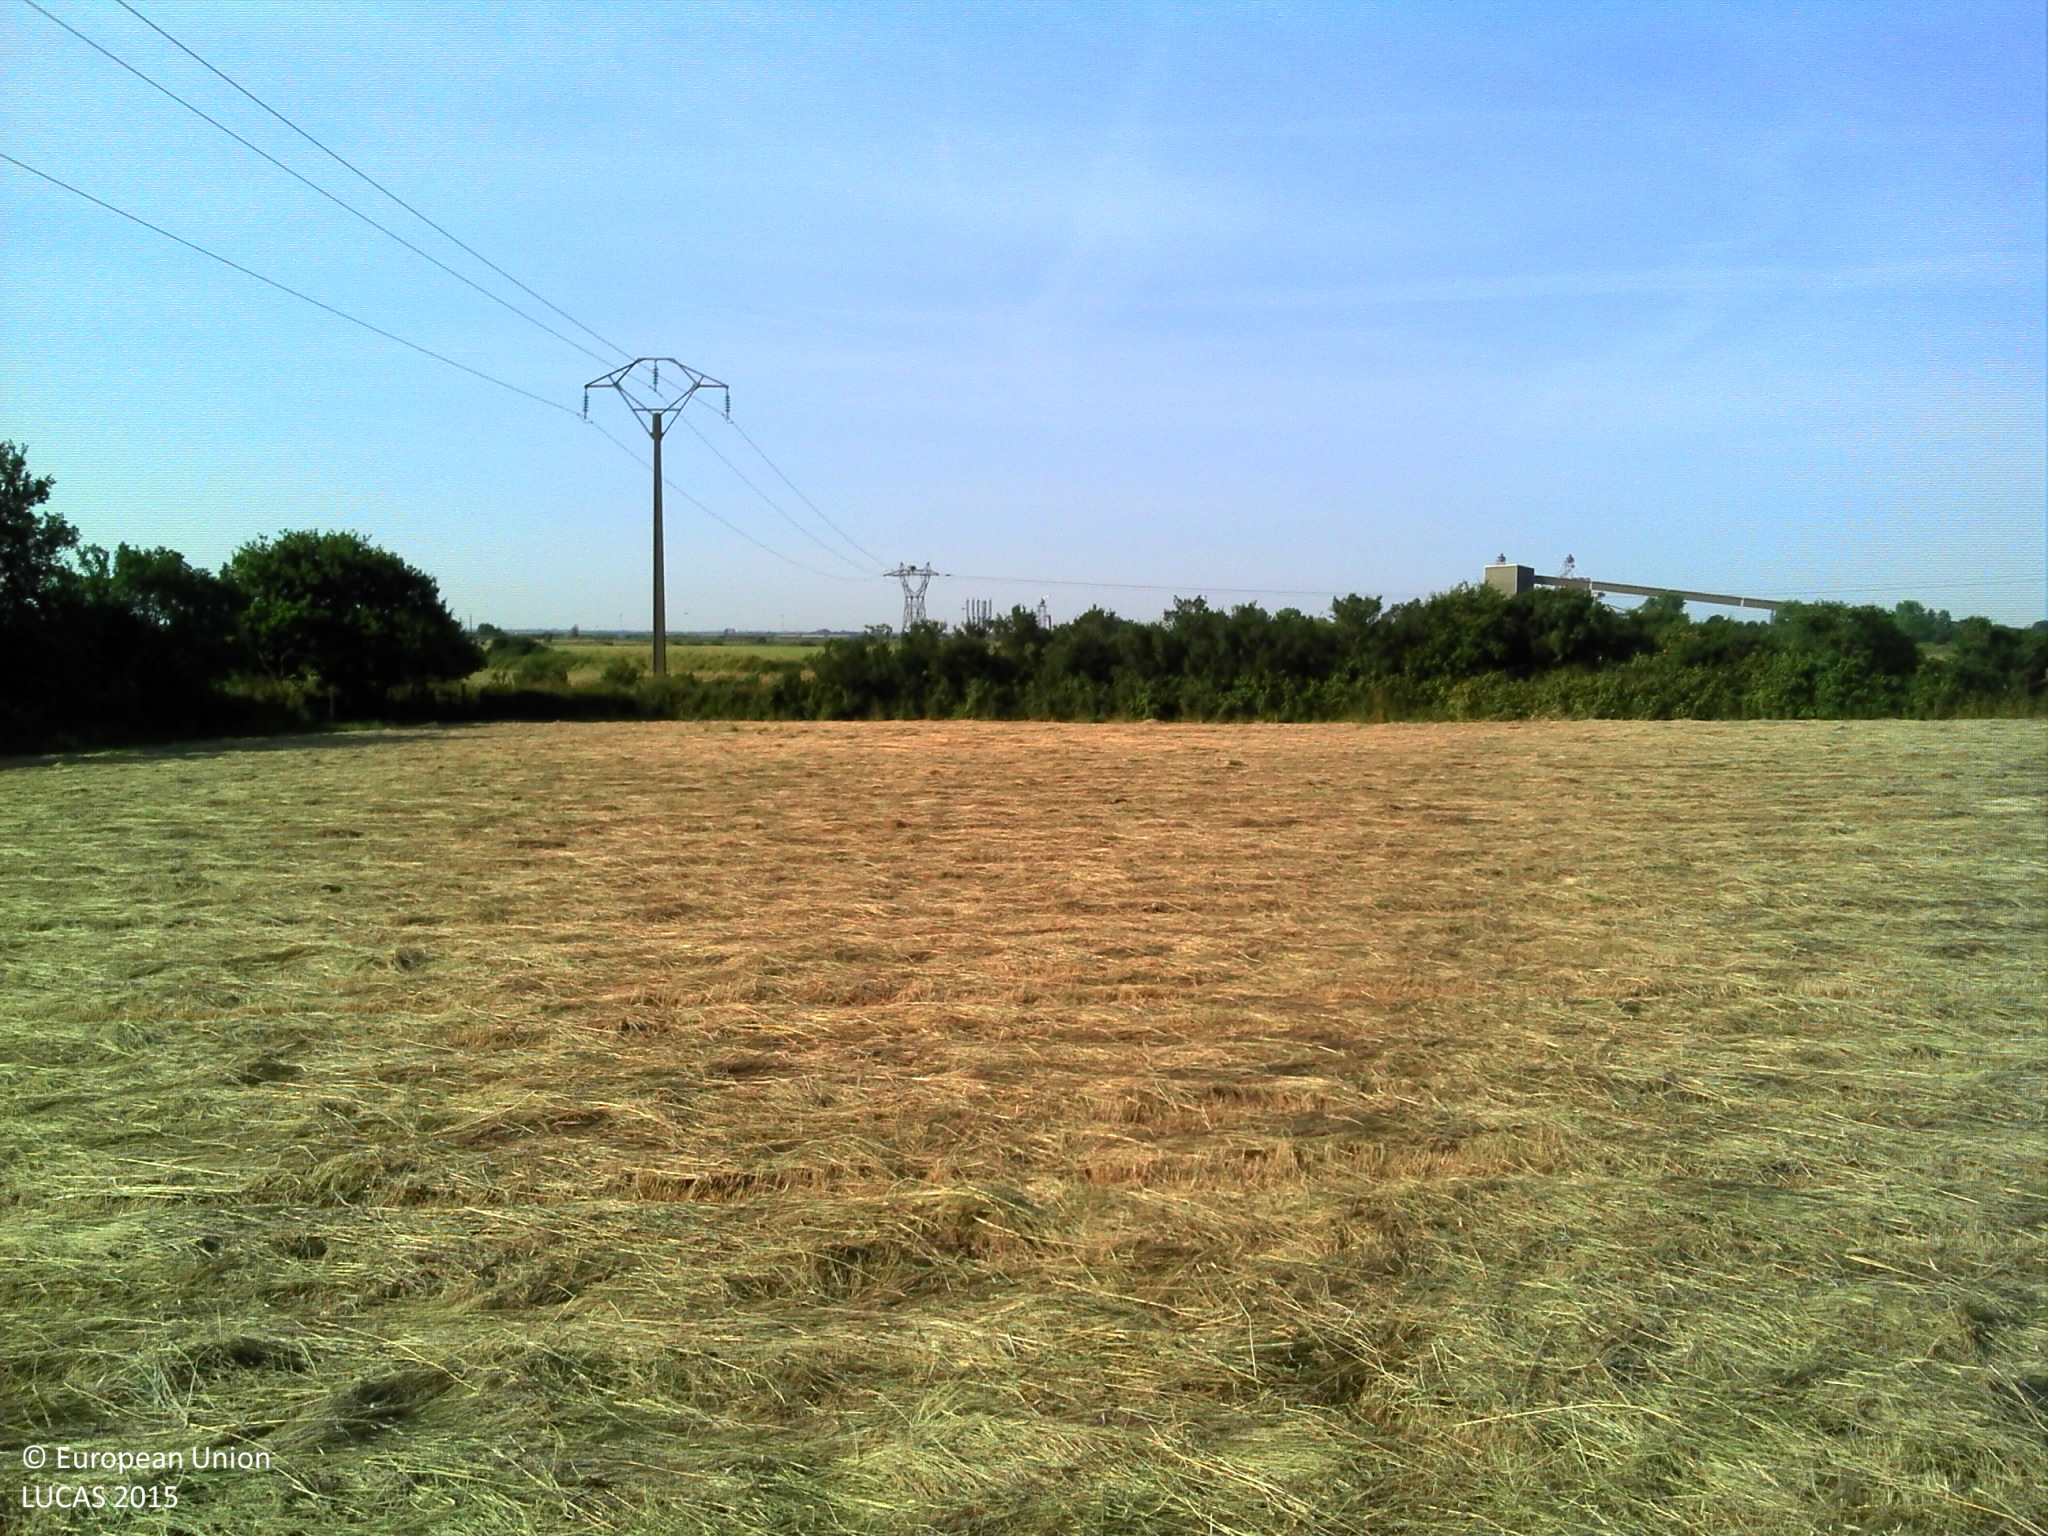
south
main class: Cropland
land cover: Temporary grasslands
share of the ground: > 75 %
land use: Agriculture (excluding fallow land and kitchen gardens)
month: June
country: FR
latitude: 47.3174
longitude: -2.1022
